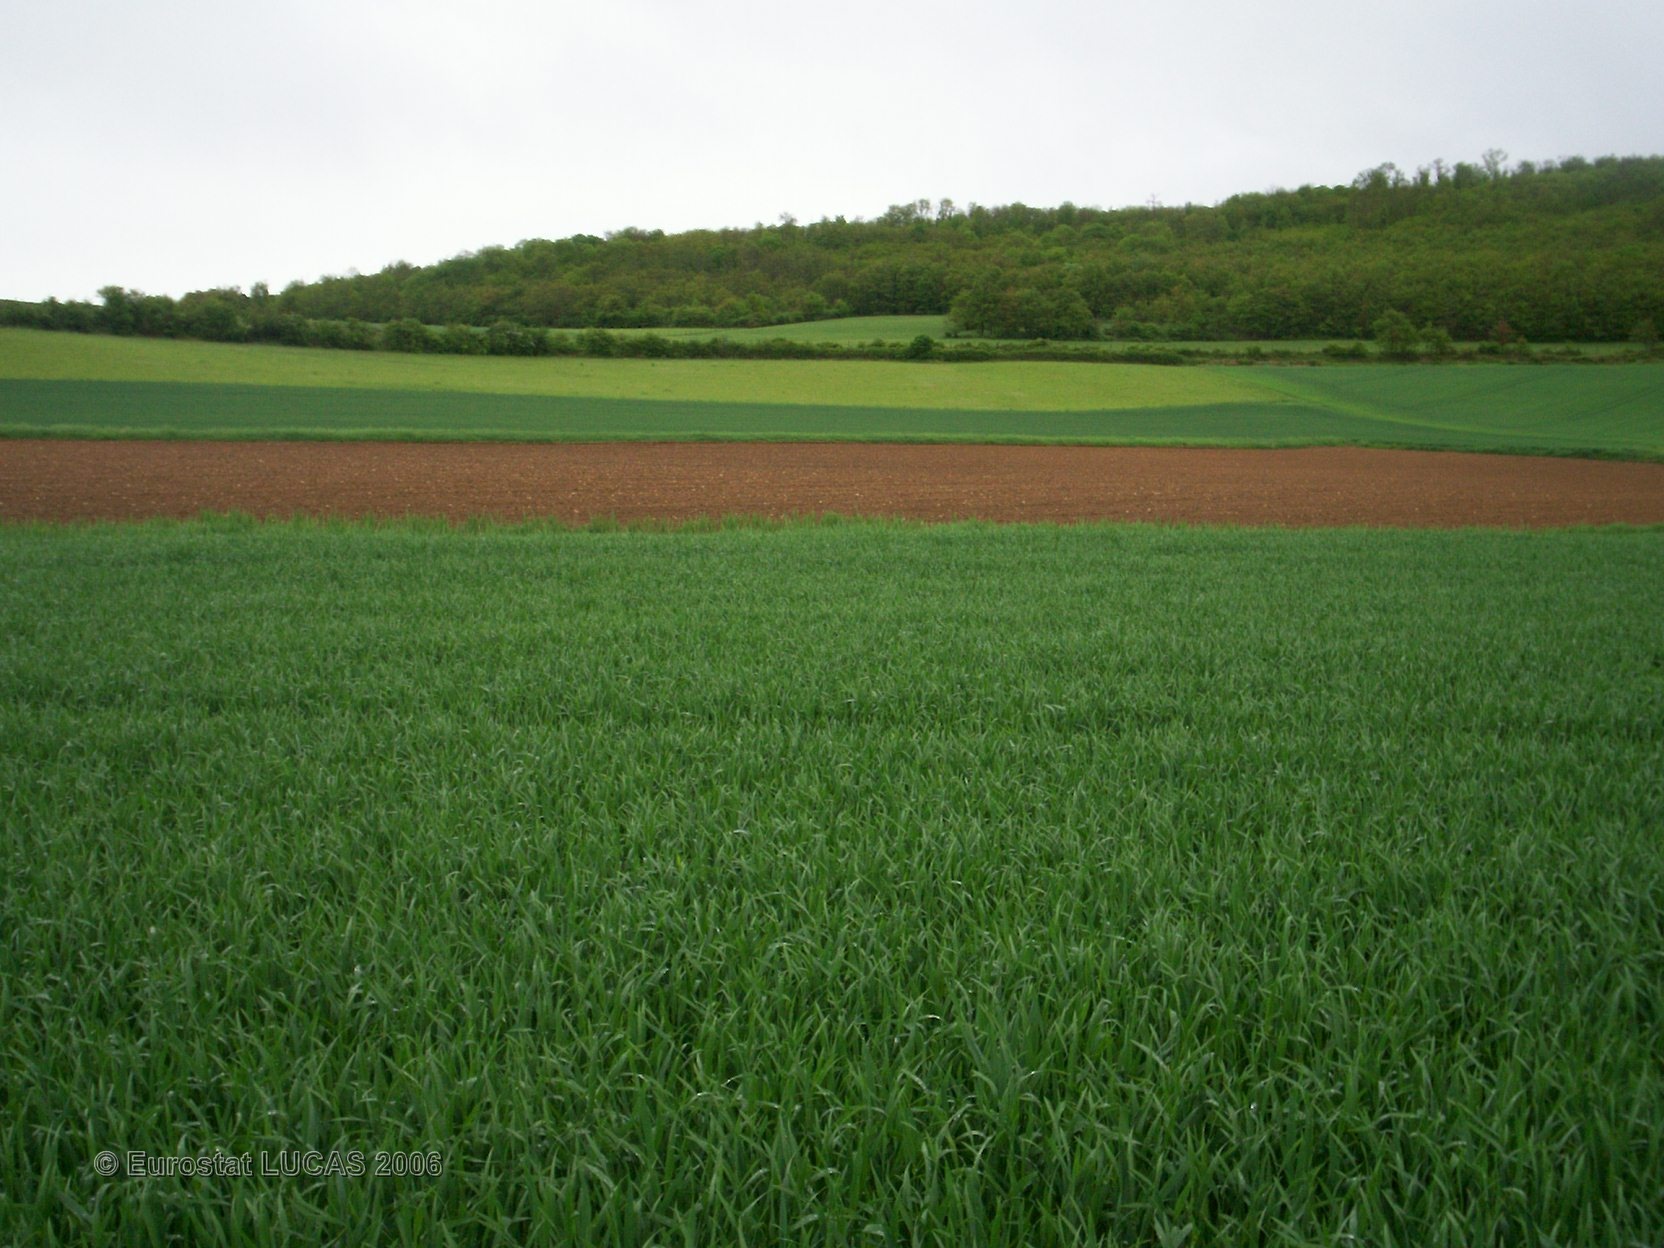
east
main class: Cropland
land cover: Common wheat
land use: Agriculture (excluding fallow land and kitchen gardens)
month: May
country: FR
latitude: 45.4306
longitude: 3.2140
